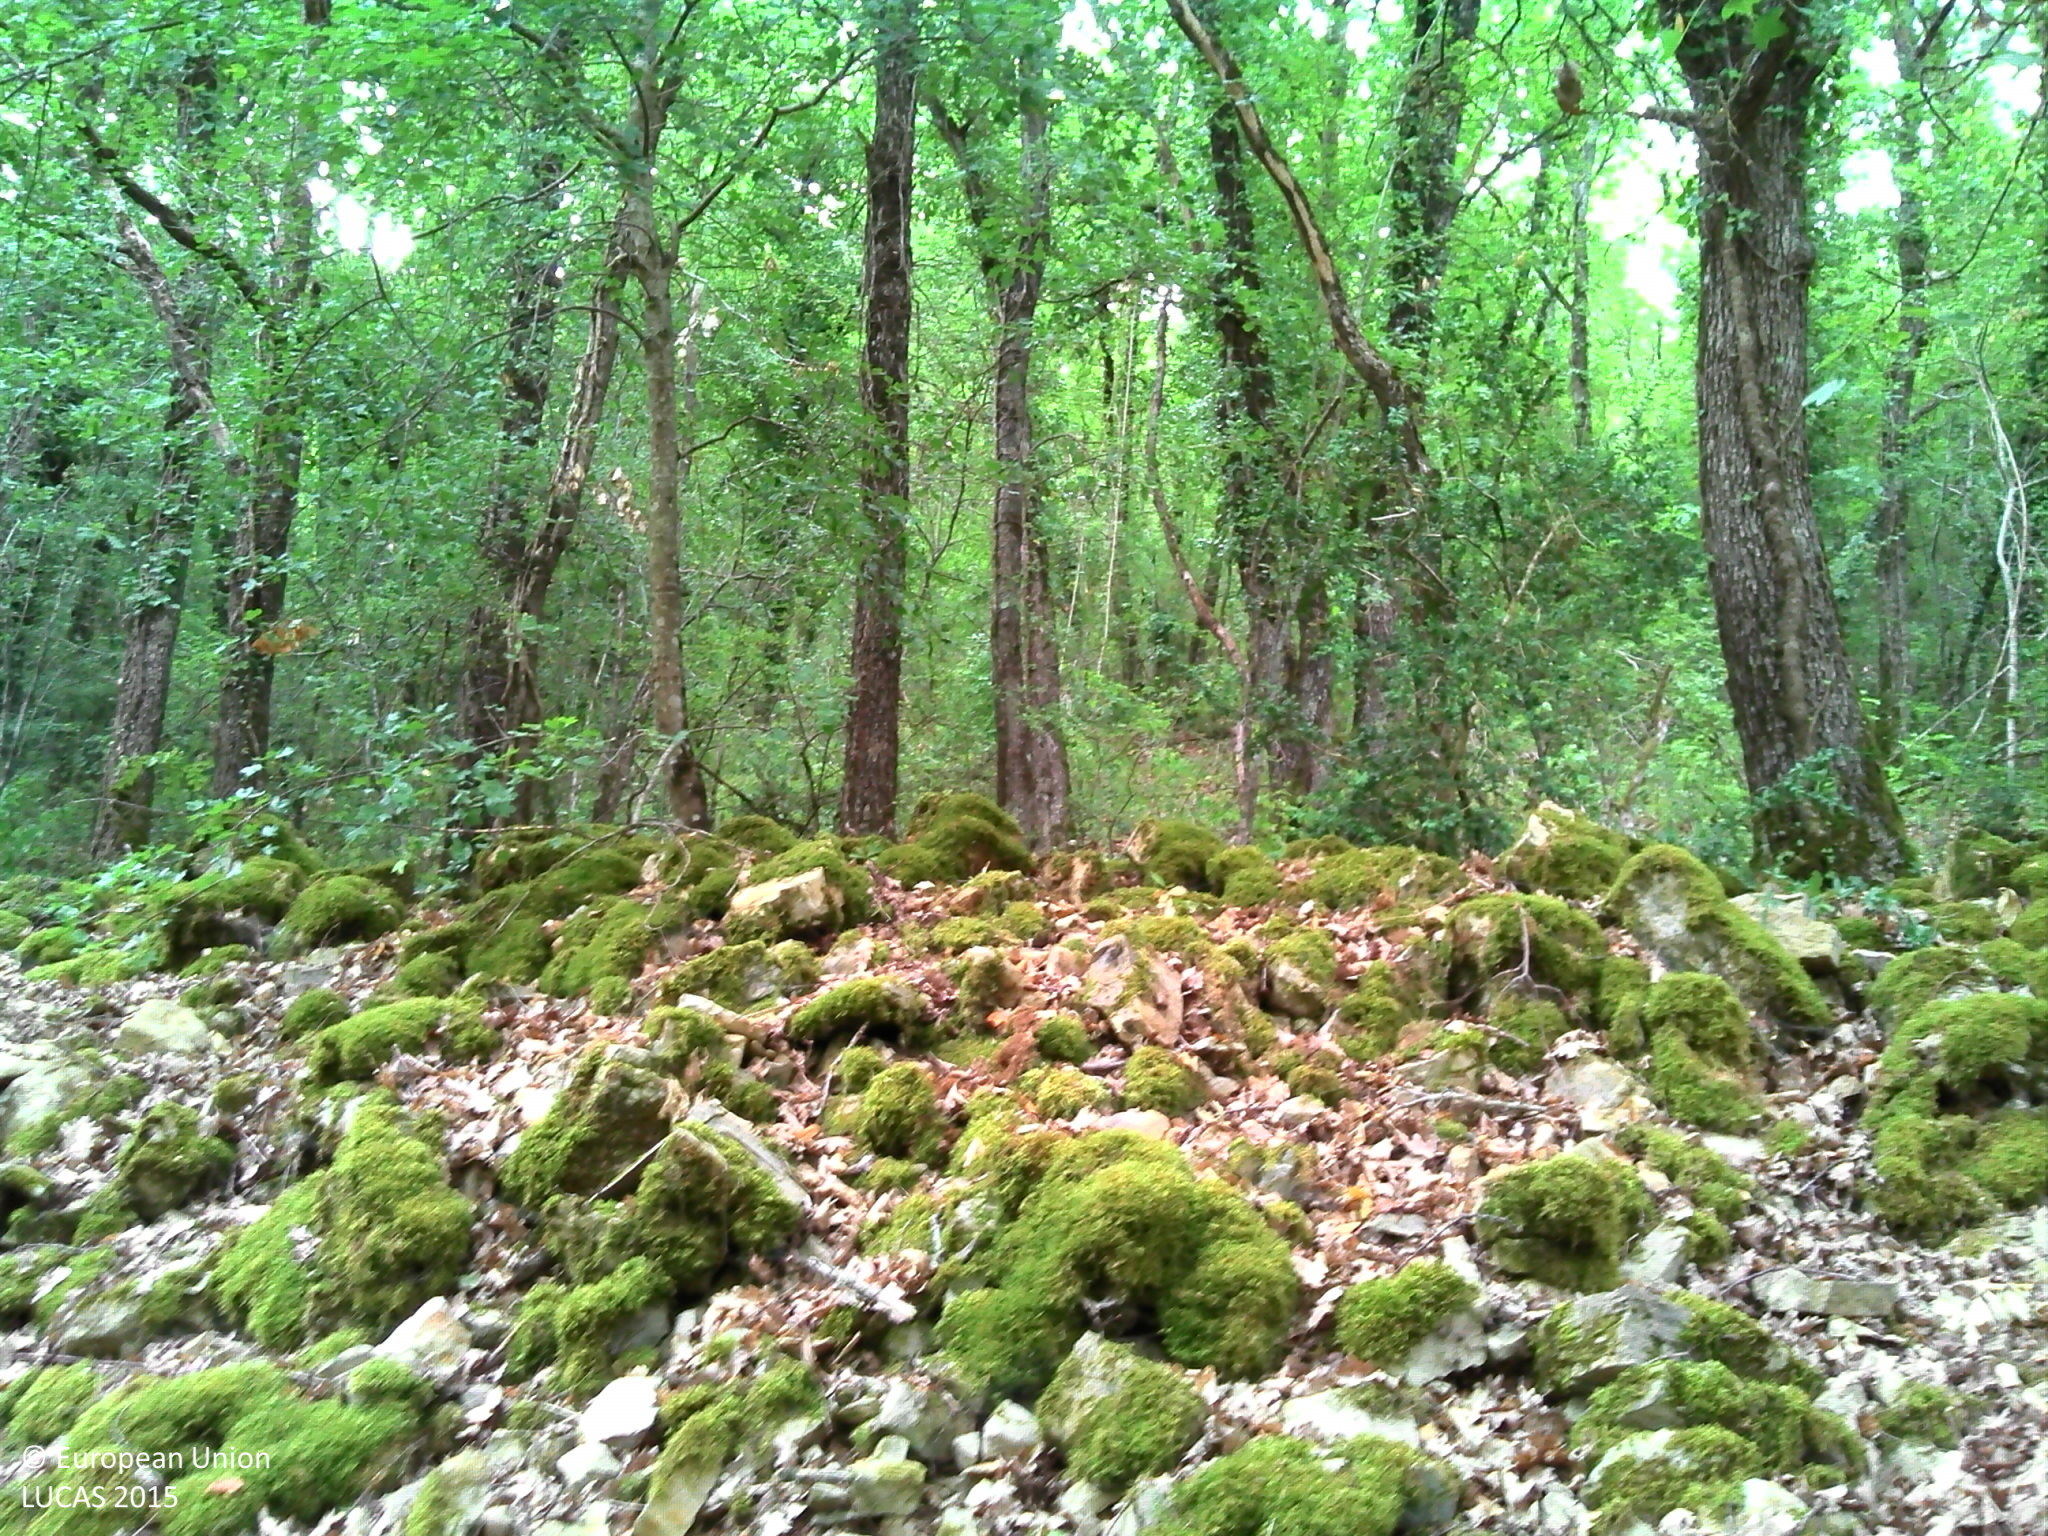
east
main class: Woodland
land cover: Broadleaved woodland
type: mesophytic deciduous forest
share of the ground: > 75 %
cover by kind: broadleaved forest trees 65 %, lichens and mosses 15 %, herbaceous plants 10 %, unconsolidated bare surface 10 %
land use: Forestry
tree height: > 5 m
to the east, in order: Broadleaved woodland; Tracks; Broadleaved woodland
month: August
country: FR
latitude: 44.0438
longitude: 3.3048
